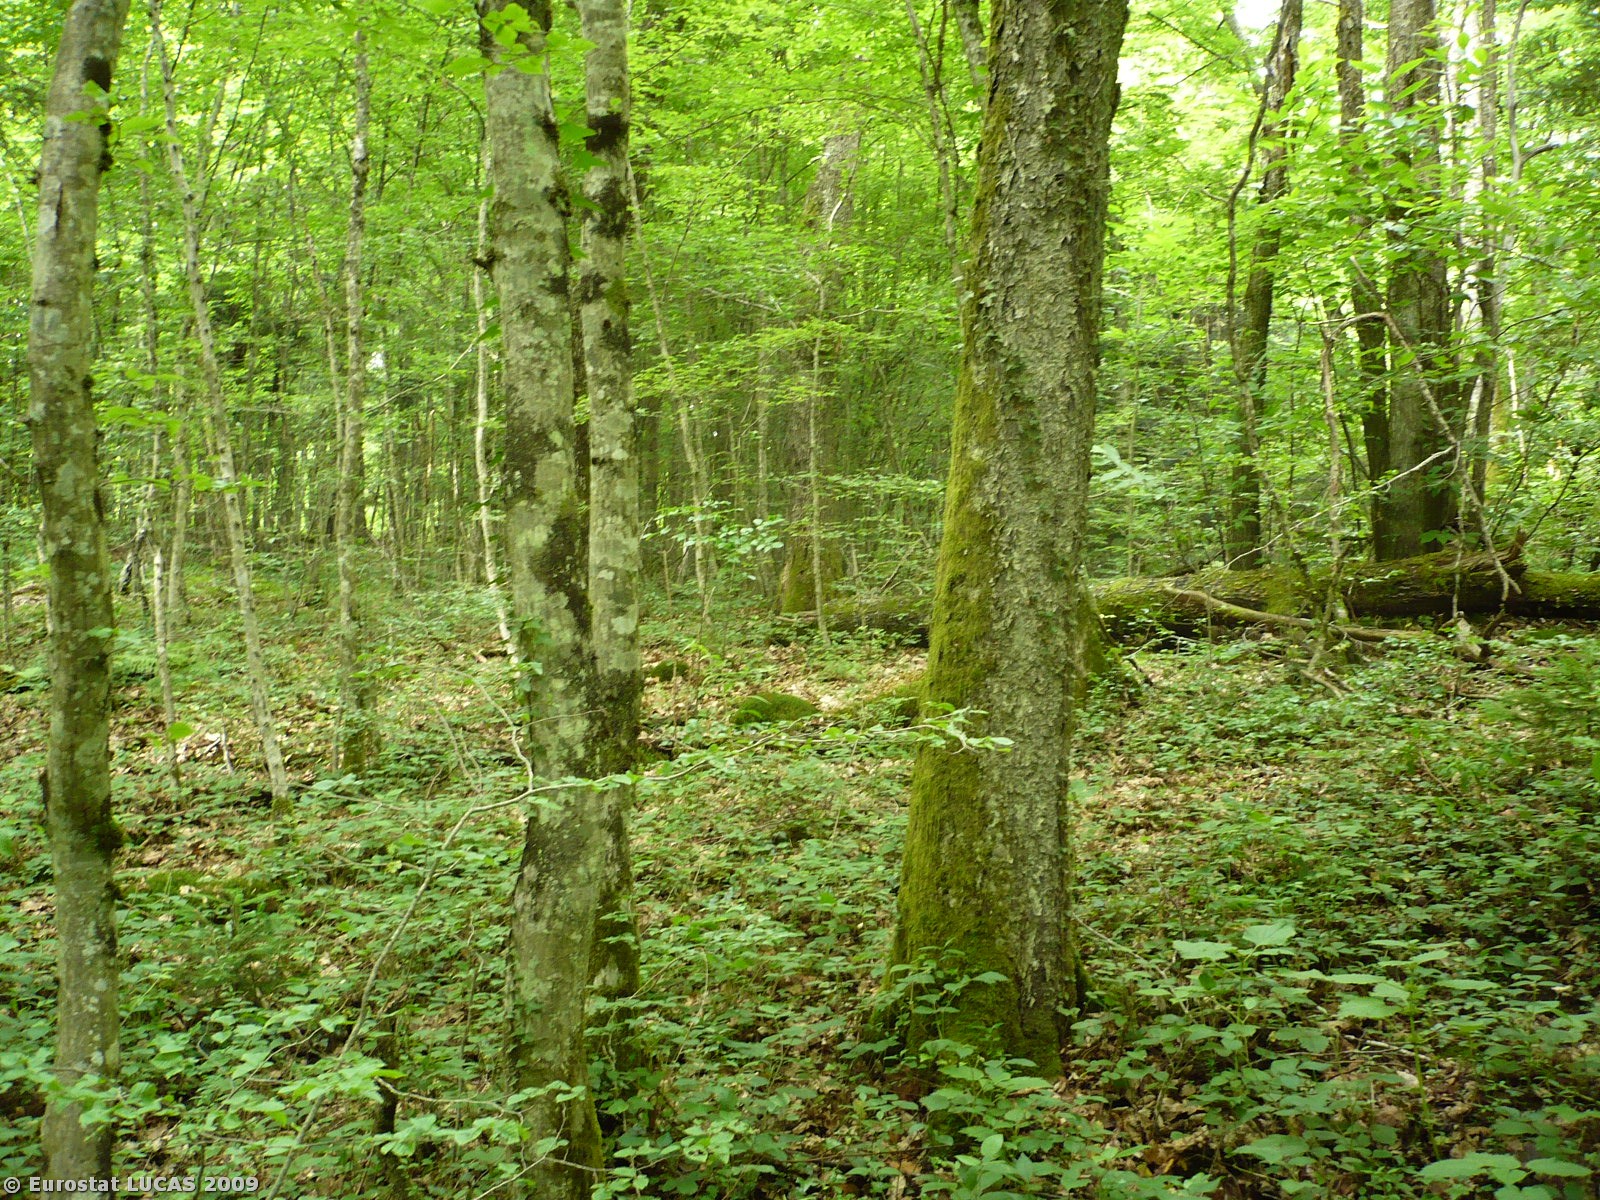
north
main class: Woodland
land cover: Broadleaved woodland
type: acidophilous oak and oak-birch forest
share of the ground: > 75 %
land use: Forestry
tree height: > 5 m
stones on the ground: < 10 %
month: June
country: SI
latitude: 45.6809
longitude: 15.2474
